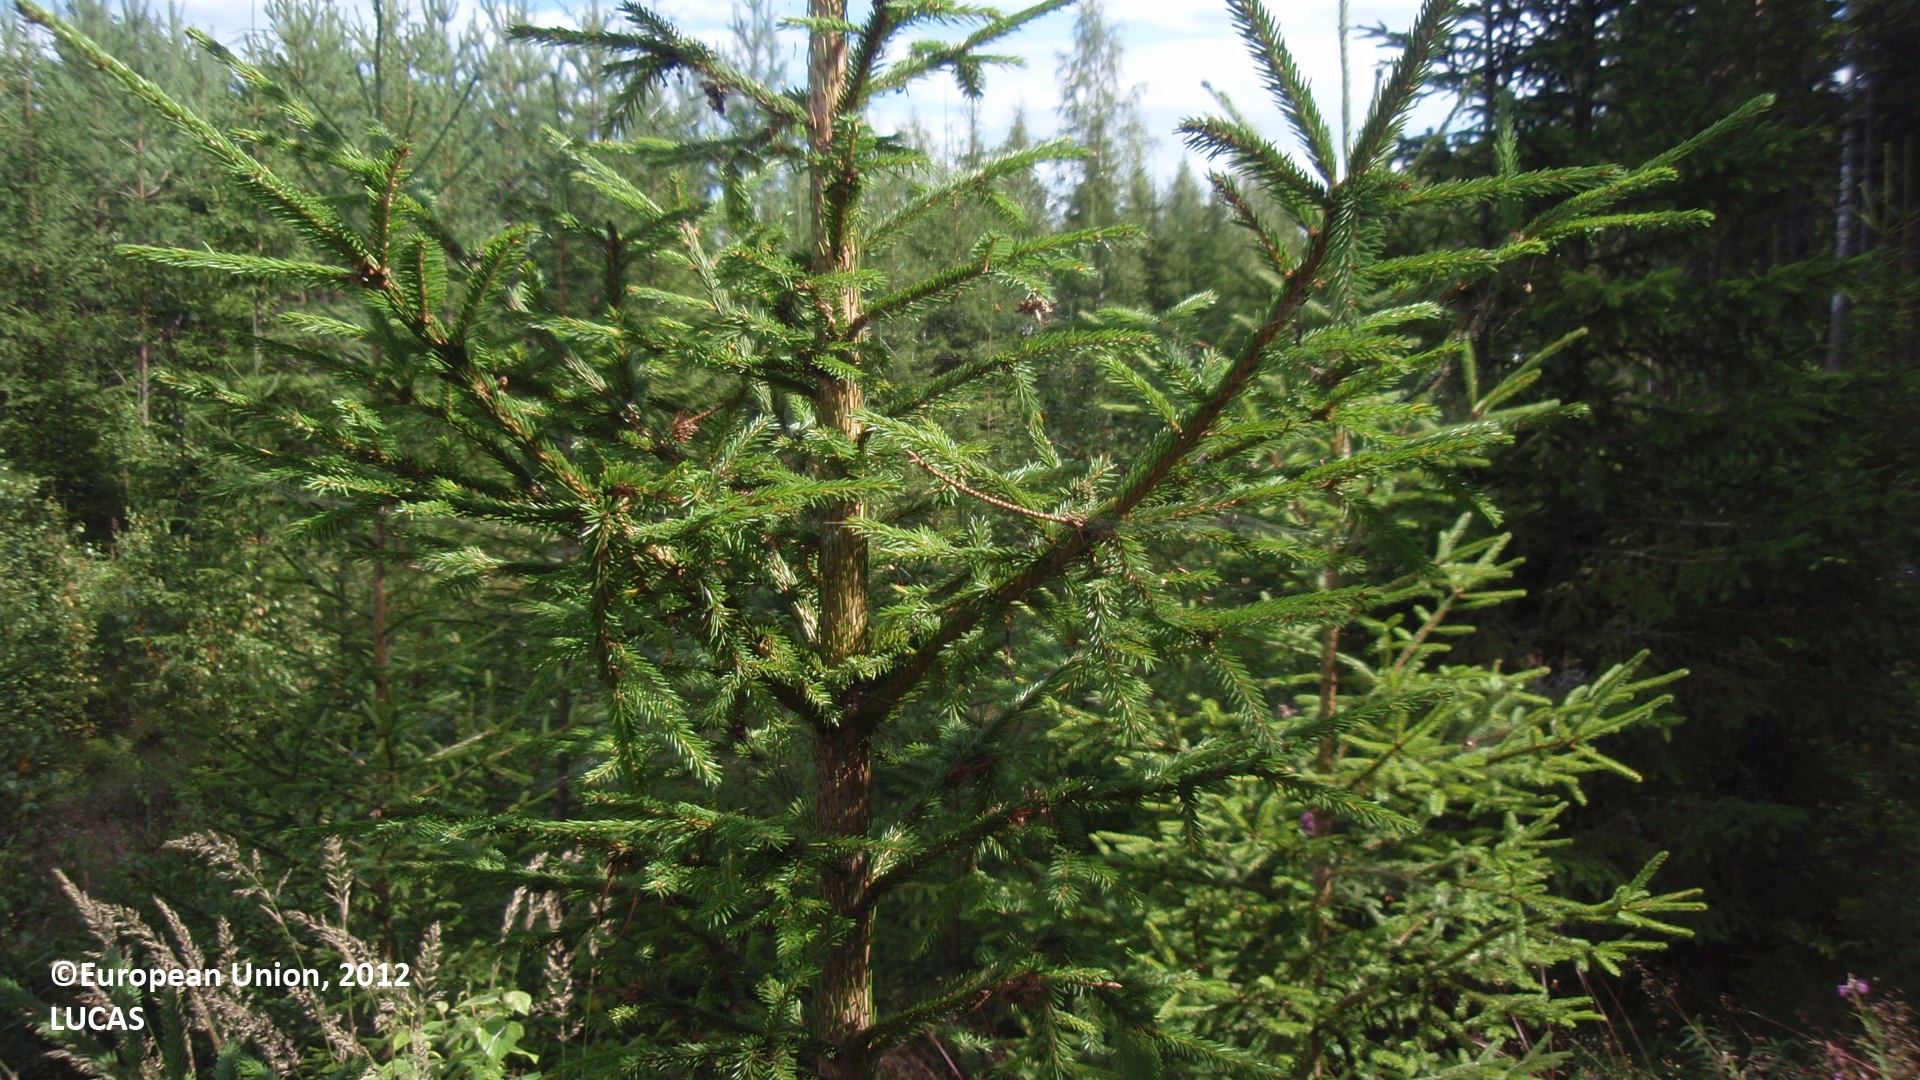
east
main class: Woodland
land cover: Spruce dominated coniferous woodland
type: boreal forest
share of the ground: 50 - 75 %
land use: Forestry
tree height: < 5 m
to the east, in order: Spruce dominated coniferous woodland
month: July
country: FI
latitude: 61.4658
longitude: 28.9385
